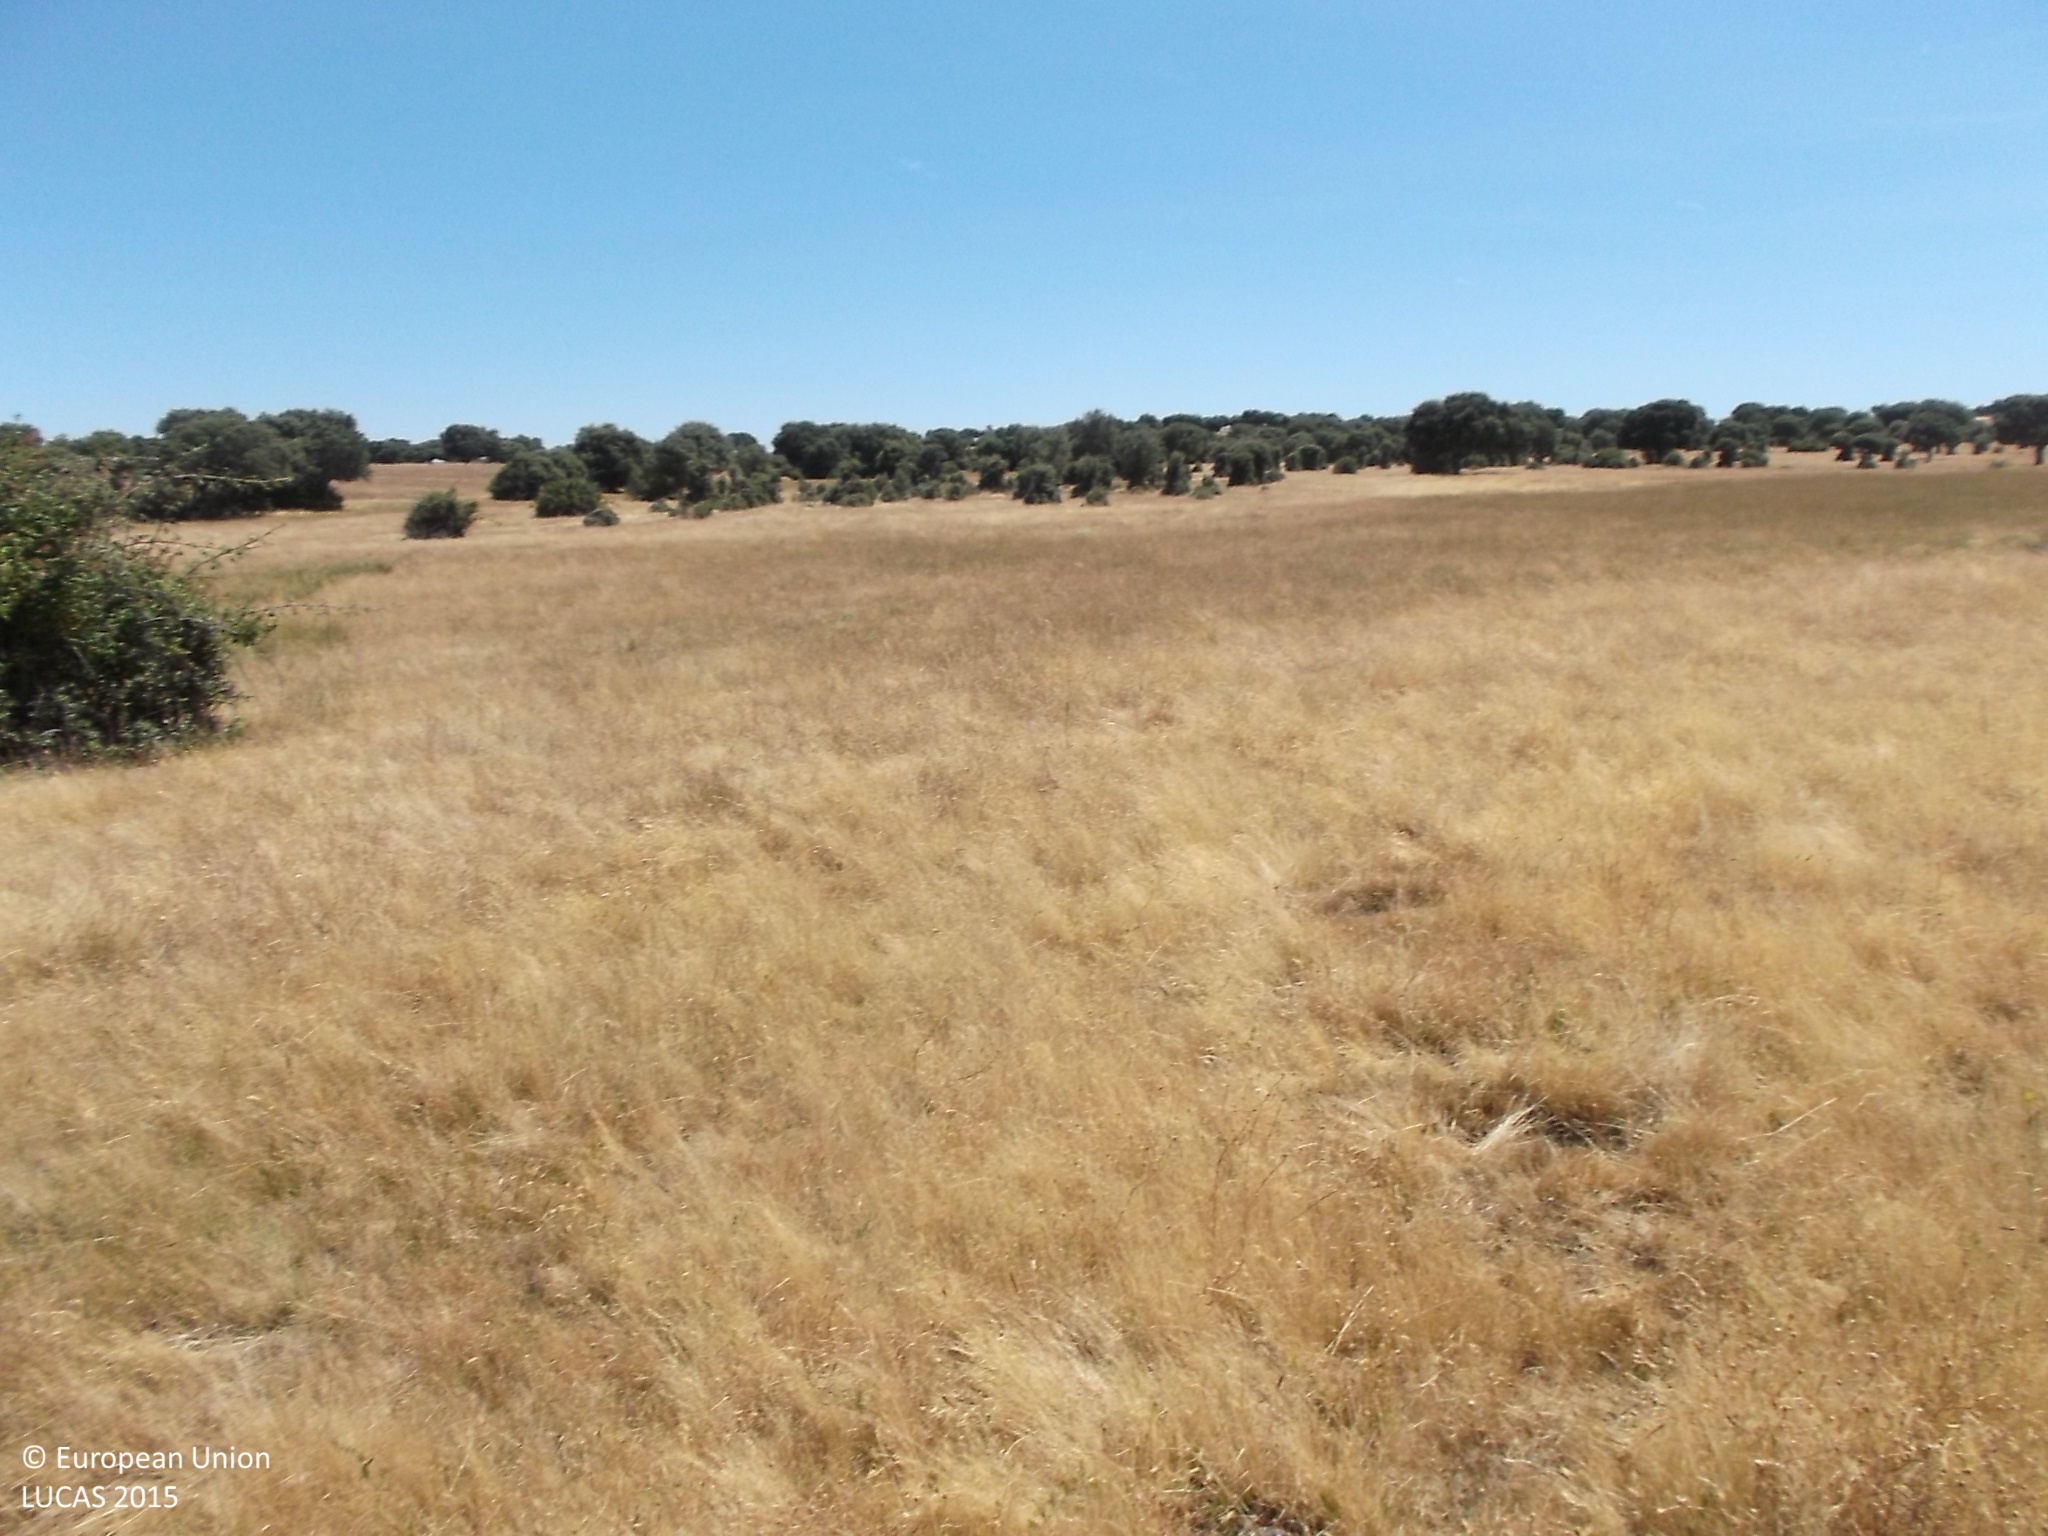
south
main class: Grassland
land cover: Grassland with sparse tree/shrub cover
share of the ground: > 75 %
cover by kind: herbaceous plants 90 %, broadleaved forest trees 5 %, shrubs 5 %
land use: Agriculture (excluding fallow land and kitchen gardens)
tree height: < 5 m
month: July
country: ES
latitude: 40.9635
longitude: -6.7956
